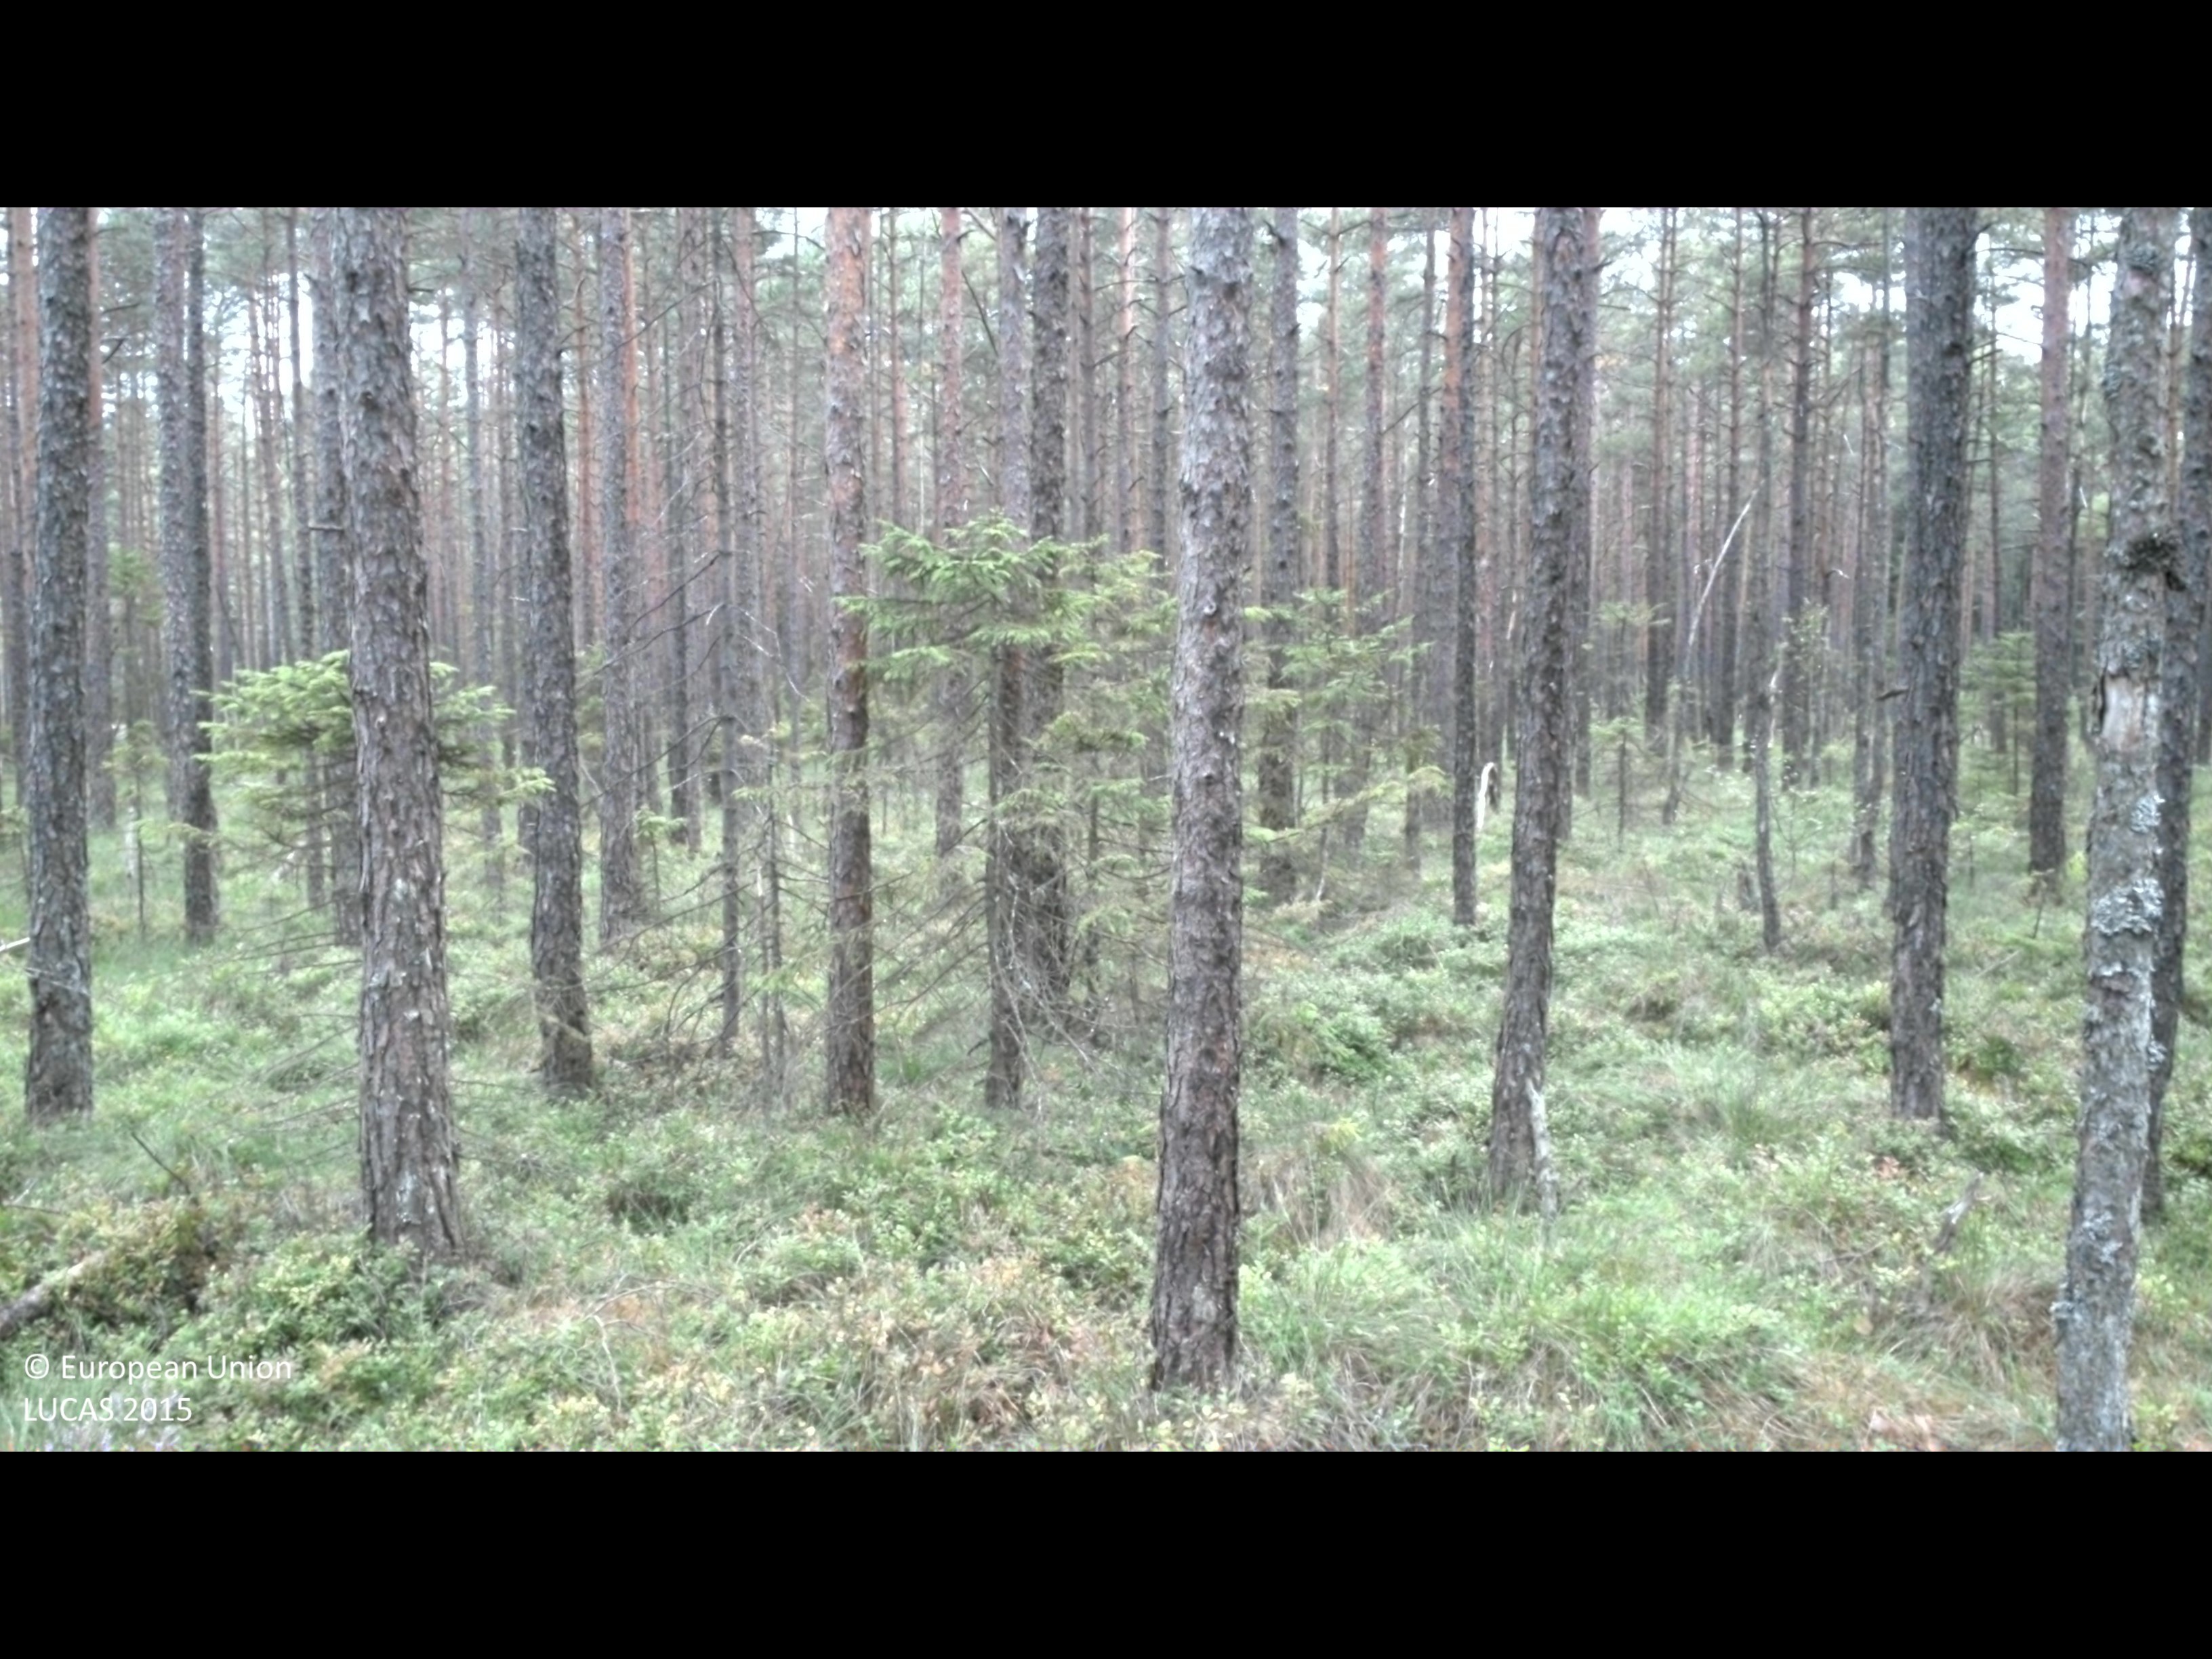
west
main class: Woodland
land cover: Pine dominated coniferous woodland
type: boreal forest
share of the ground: 50 - 75 %
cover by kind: coniferous forest trees 70 %, shrubs 30 %
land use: Forestry
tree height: > 5 m
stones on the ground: < 10 %
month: August
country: SE
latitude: 56.9044
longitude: 13.1657
